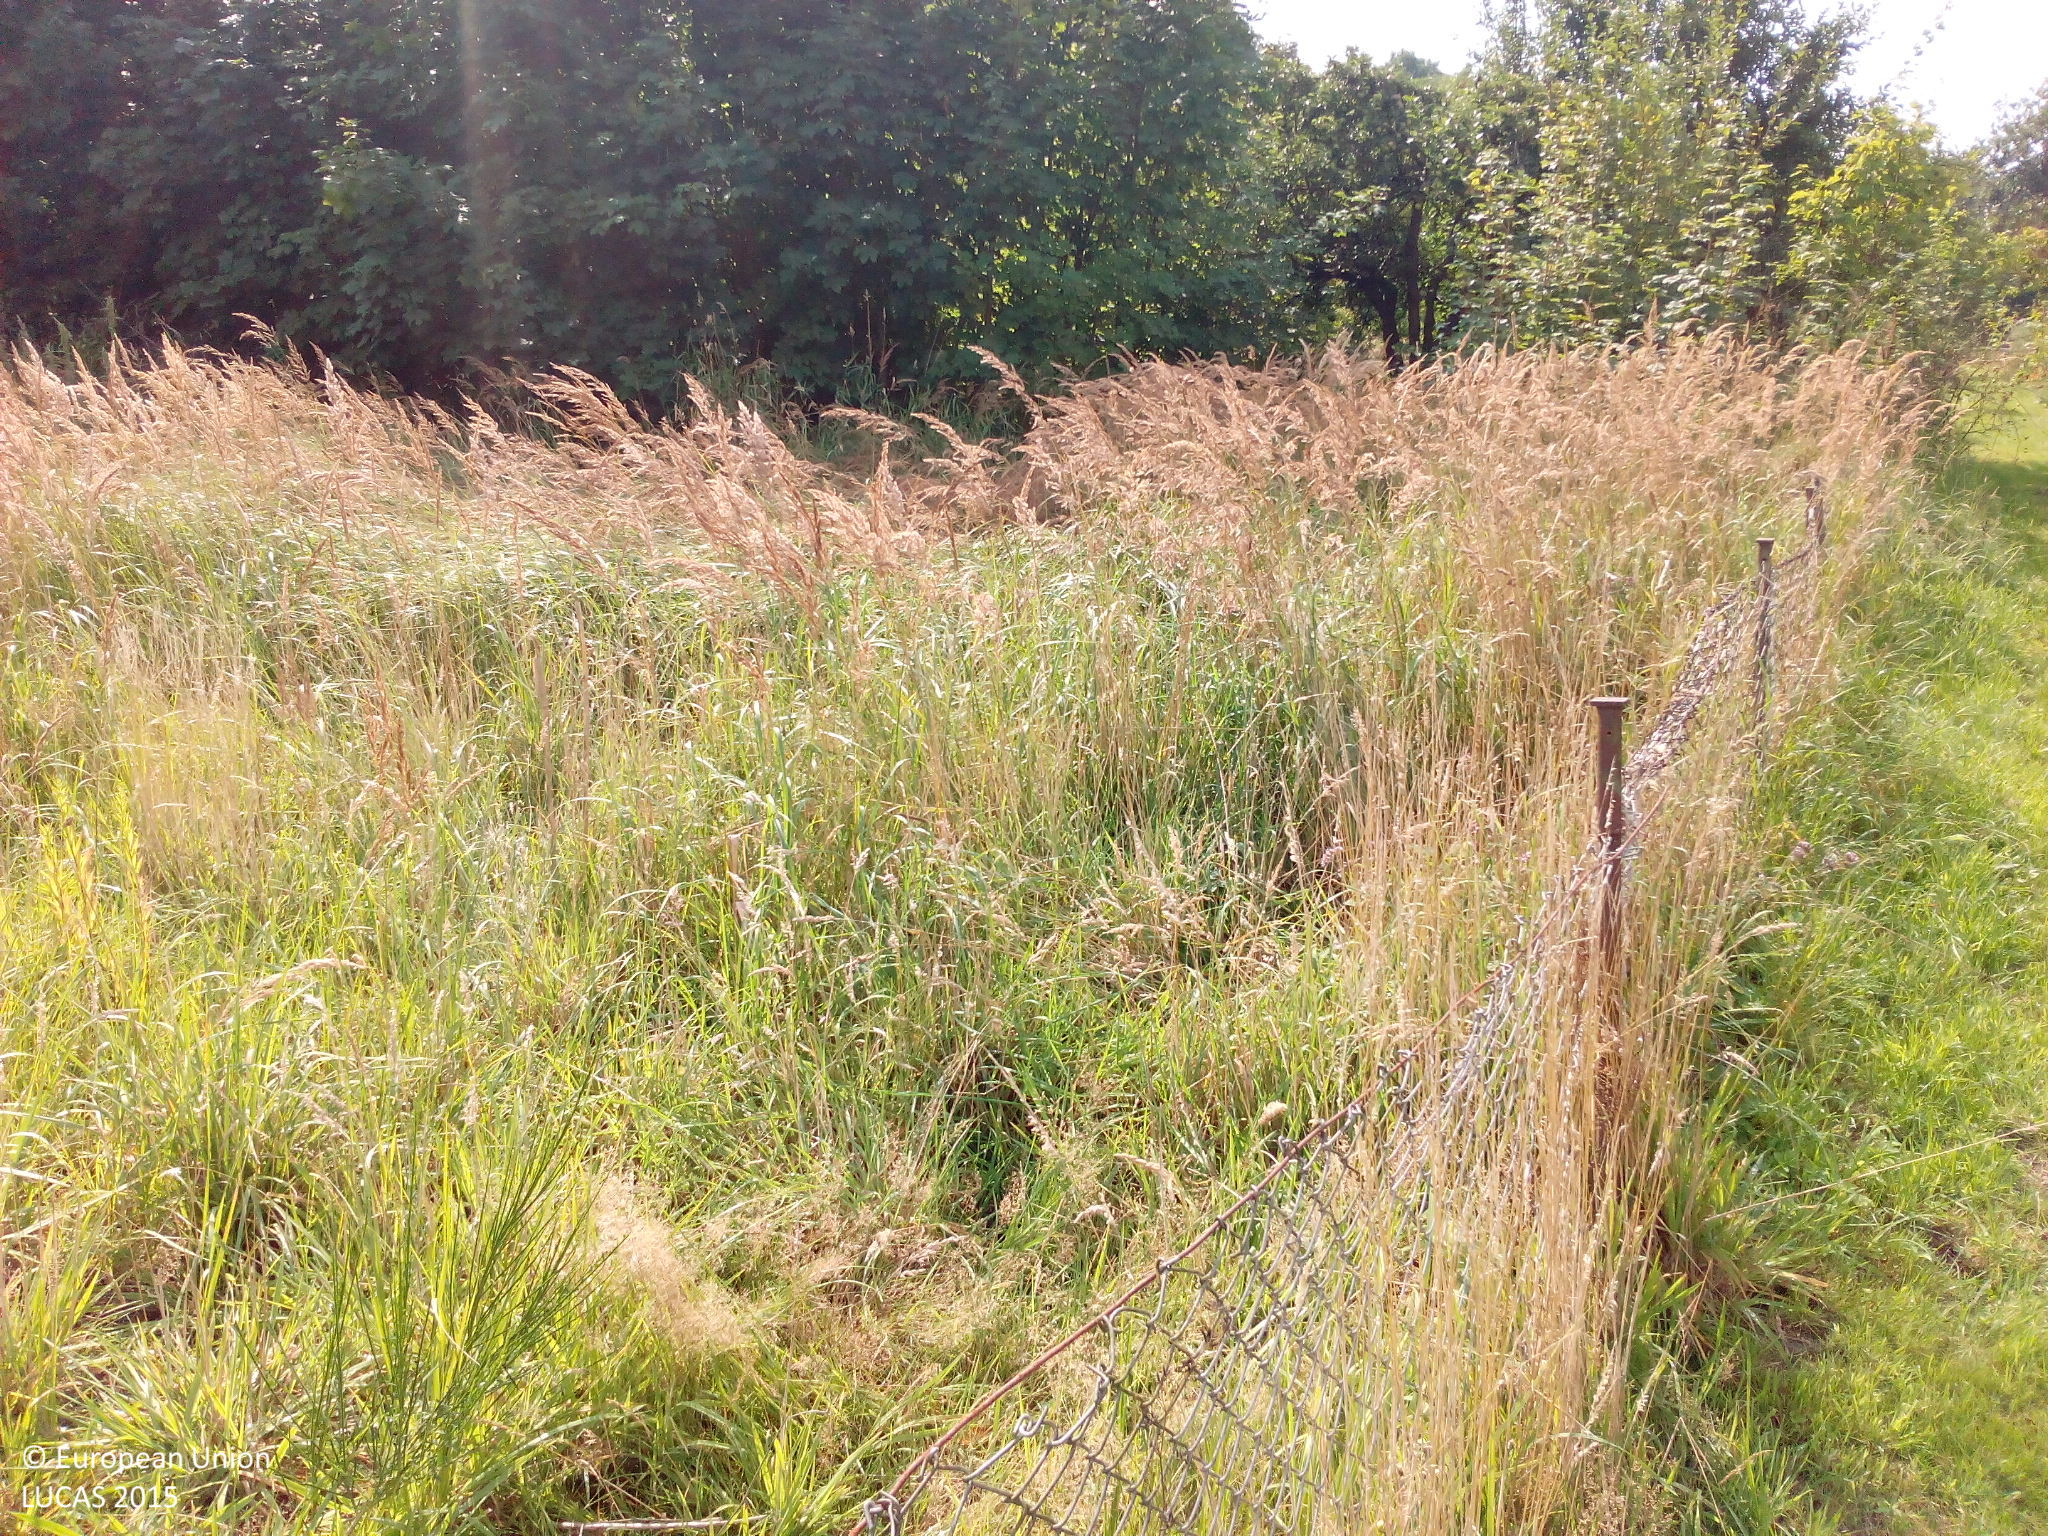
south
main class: Grassland
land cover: Grassland with sparse tree/shrub cover
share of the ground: > 75 %
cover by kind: herbaceous plants 95 %, broadleaved forest trees 5 %
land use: Residential
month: August
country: DE
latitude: 54.1822
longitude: 12.6499
